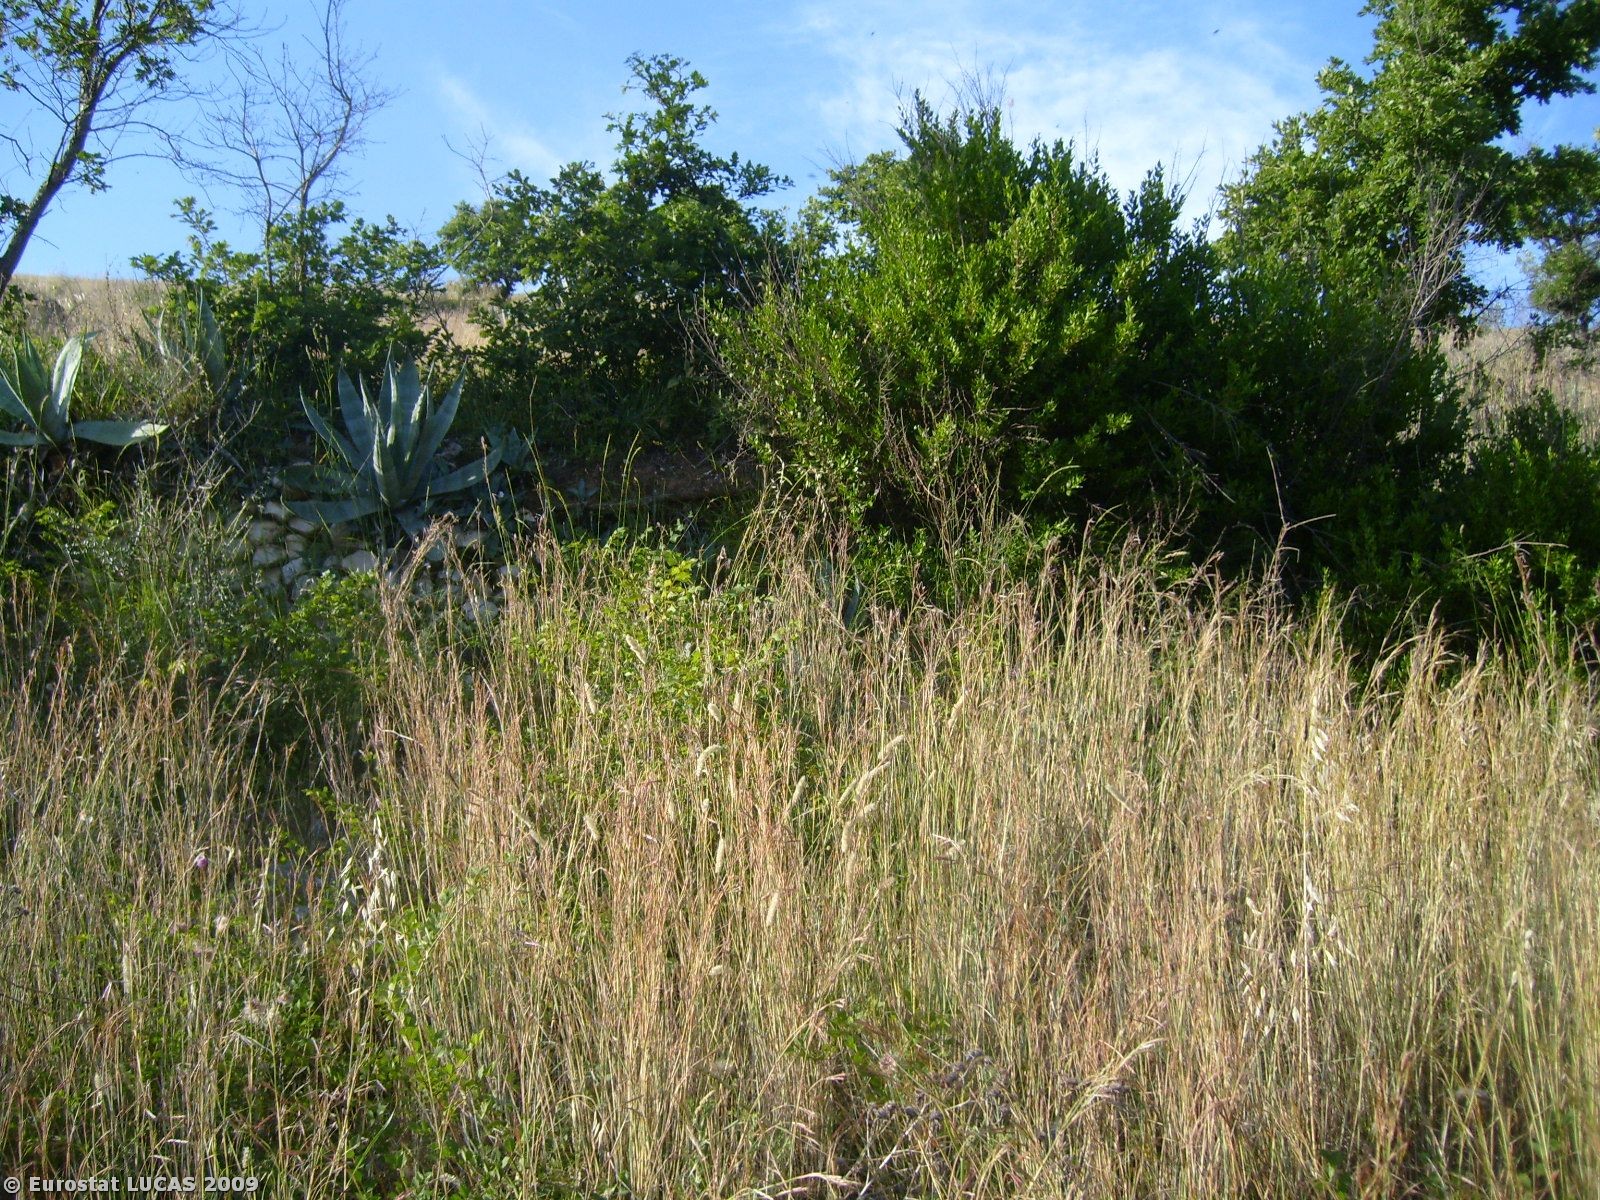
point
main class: Shrubland
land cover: Shrubland with sparse tree cover
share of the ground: > 75 %
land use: Fallow land
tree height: < 5 m
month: June
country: IT
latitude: 41.1319
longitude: 14.3310
